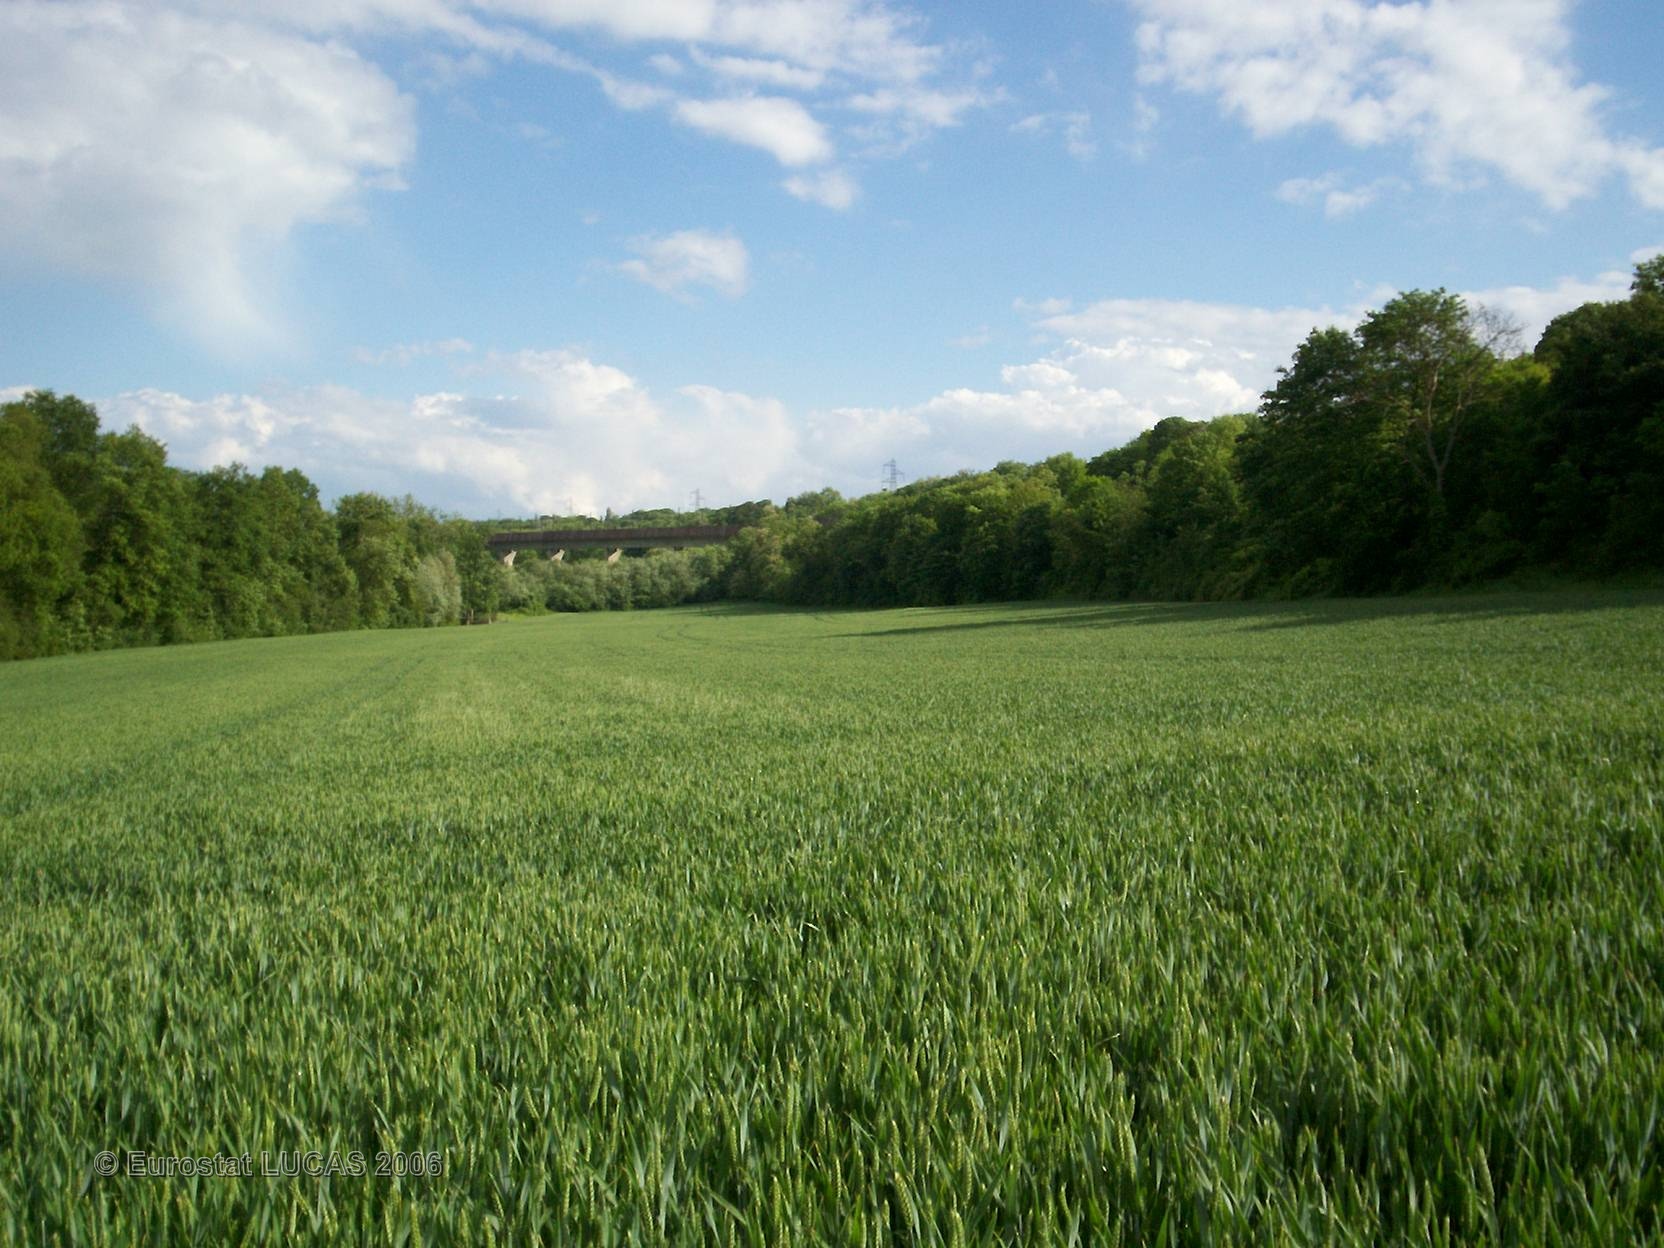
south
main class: Cropland
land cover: Common wheat
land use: Agriculture (excluding fallow land and kitchen gardens)
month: May
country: FR
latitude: 48.9074
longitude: 2.7727
